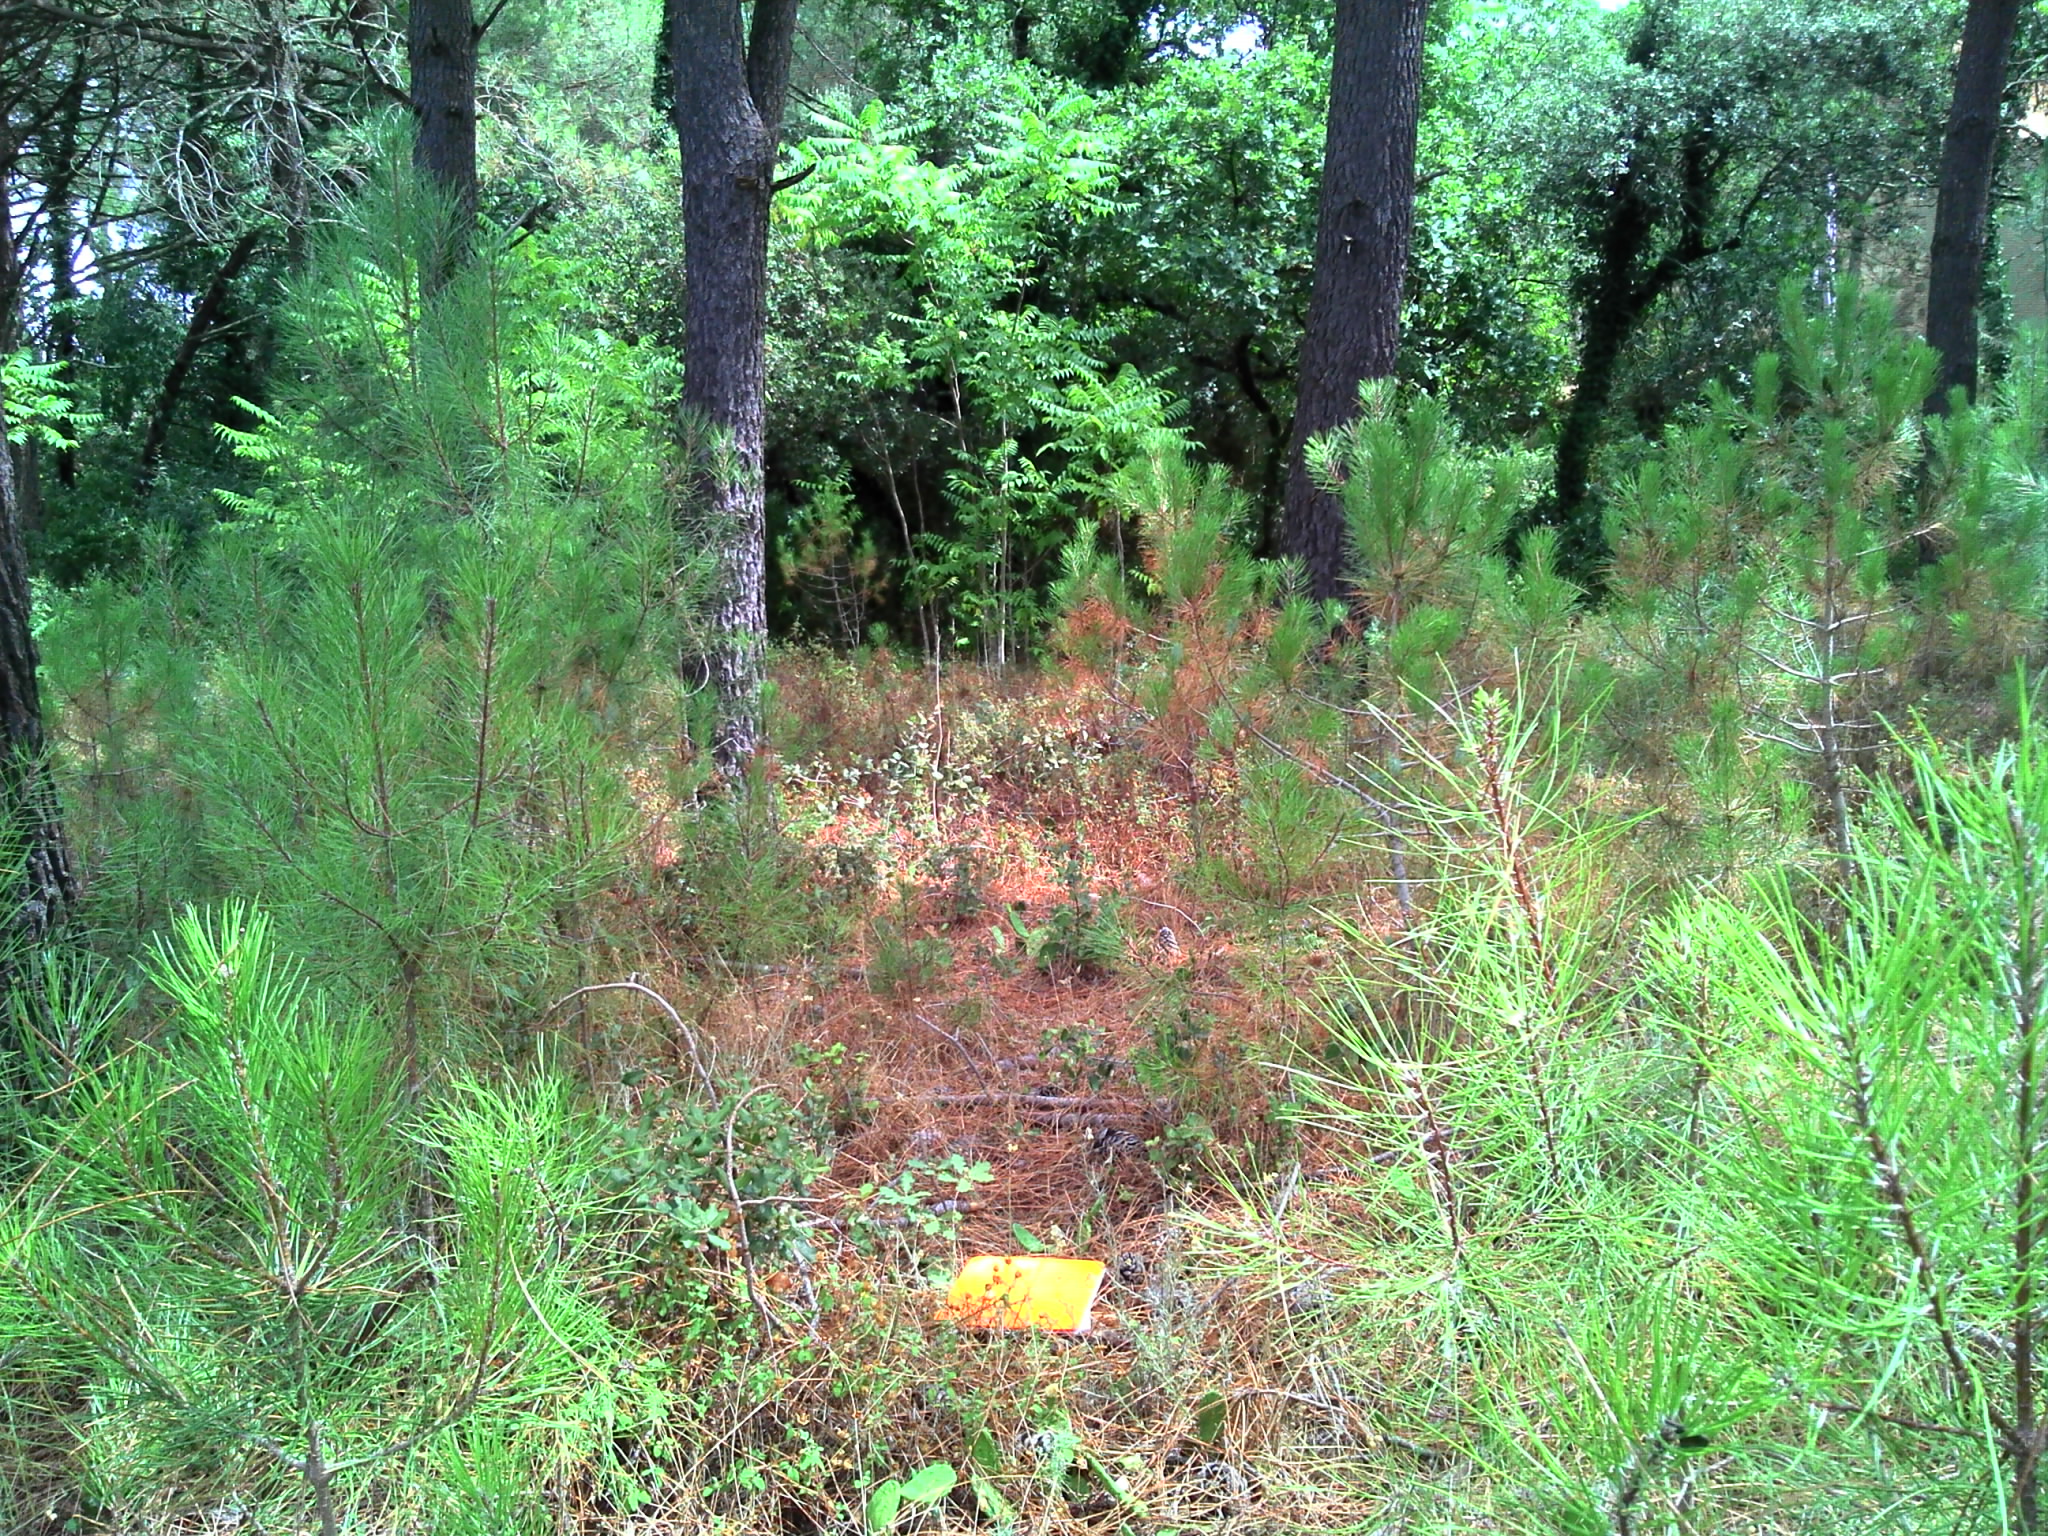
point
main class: Woodland
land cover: Pine dominated coniferous woodland
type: coniferous forest of the mediterranean region
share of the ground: > 75 %
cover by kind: coniferous forest trees 60 %, herbaceous plants 20 %, shrubs 10 %, consolidated bare surface 10 %
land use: Semi-natural and natural areas not in use
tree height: > 5 m
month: August
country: FR
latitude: 44.1387
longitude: 4.6204
